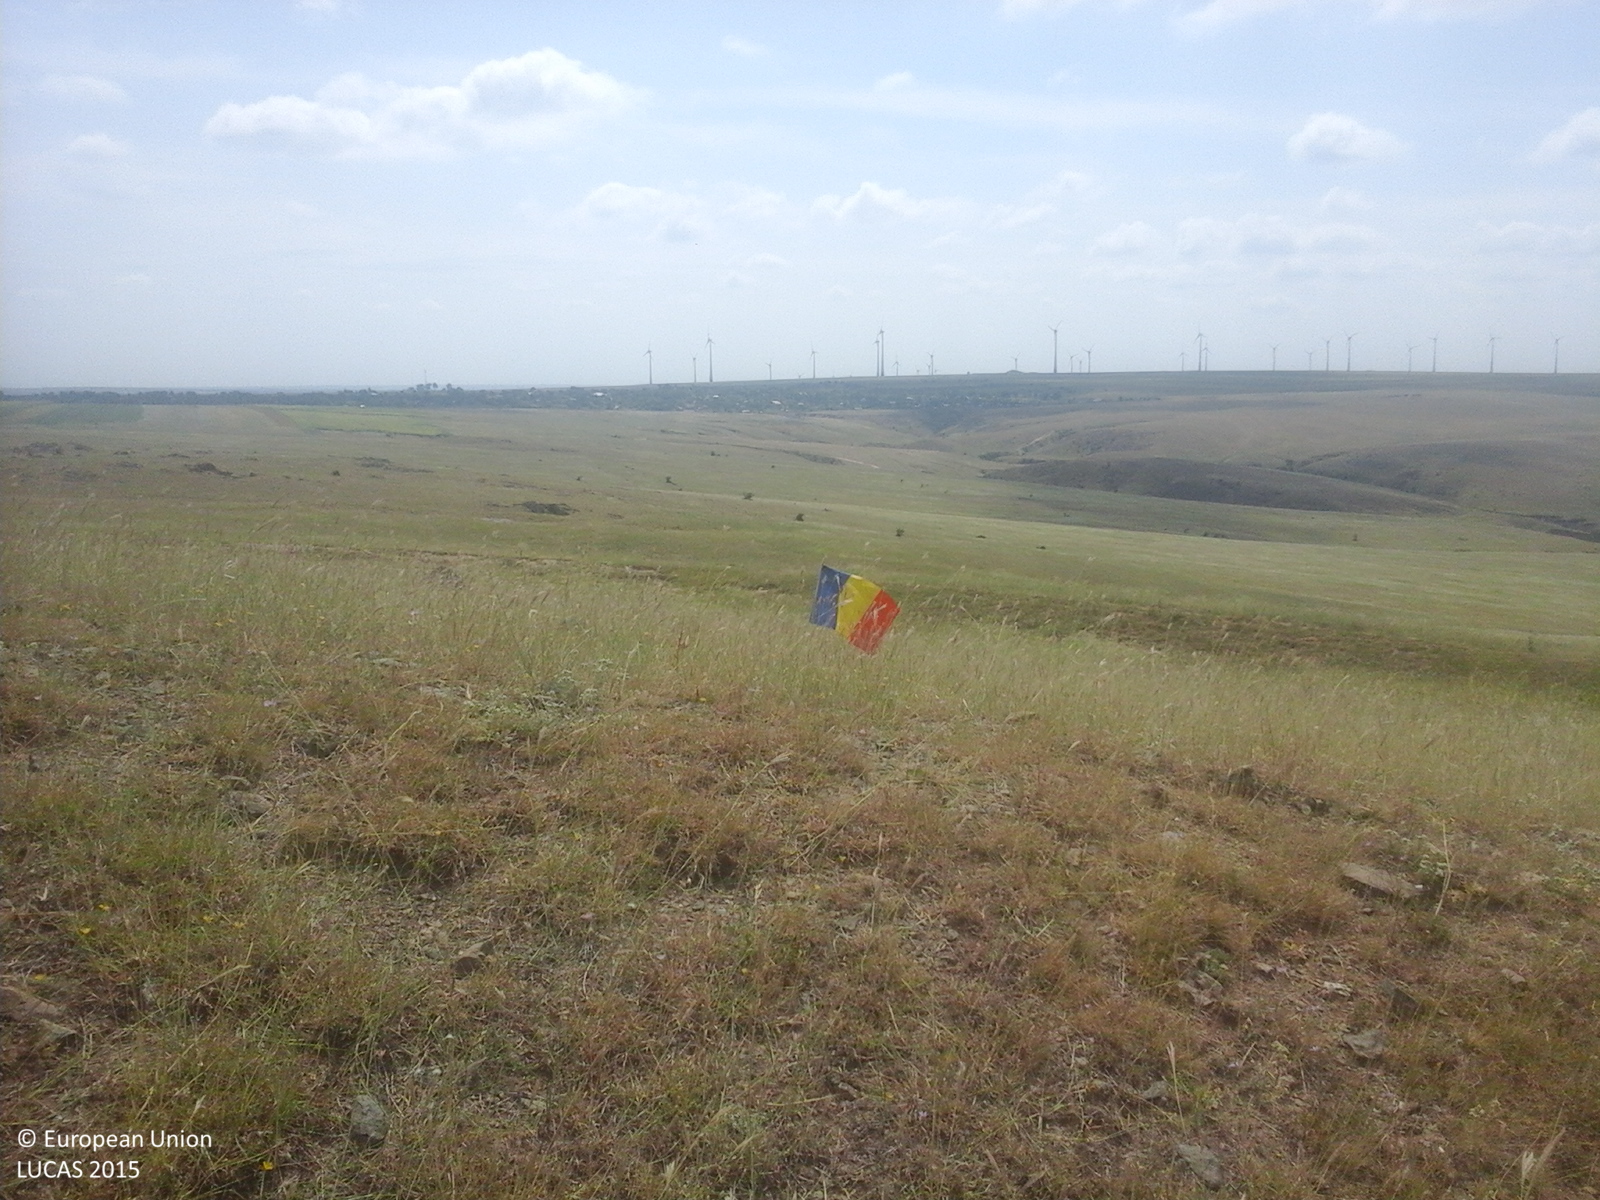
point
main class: Grassland
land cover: Grassland without tree/shrub cover
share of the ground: > 75 %
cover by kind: herbaceous plants 90 %, unconsolidated bare surface 10 %
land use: Agriculture (excluding fallow land and kitchen gardens)
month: August
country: RO
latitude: 44.7508
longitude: 28.3221
